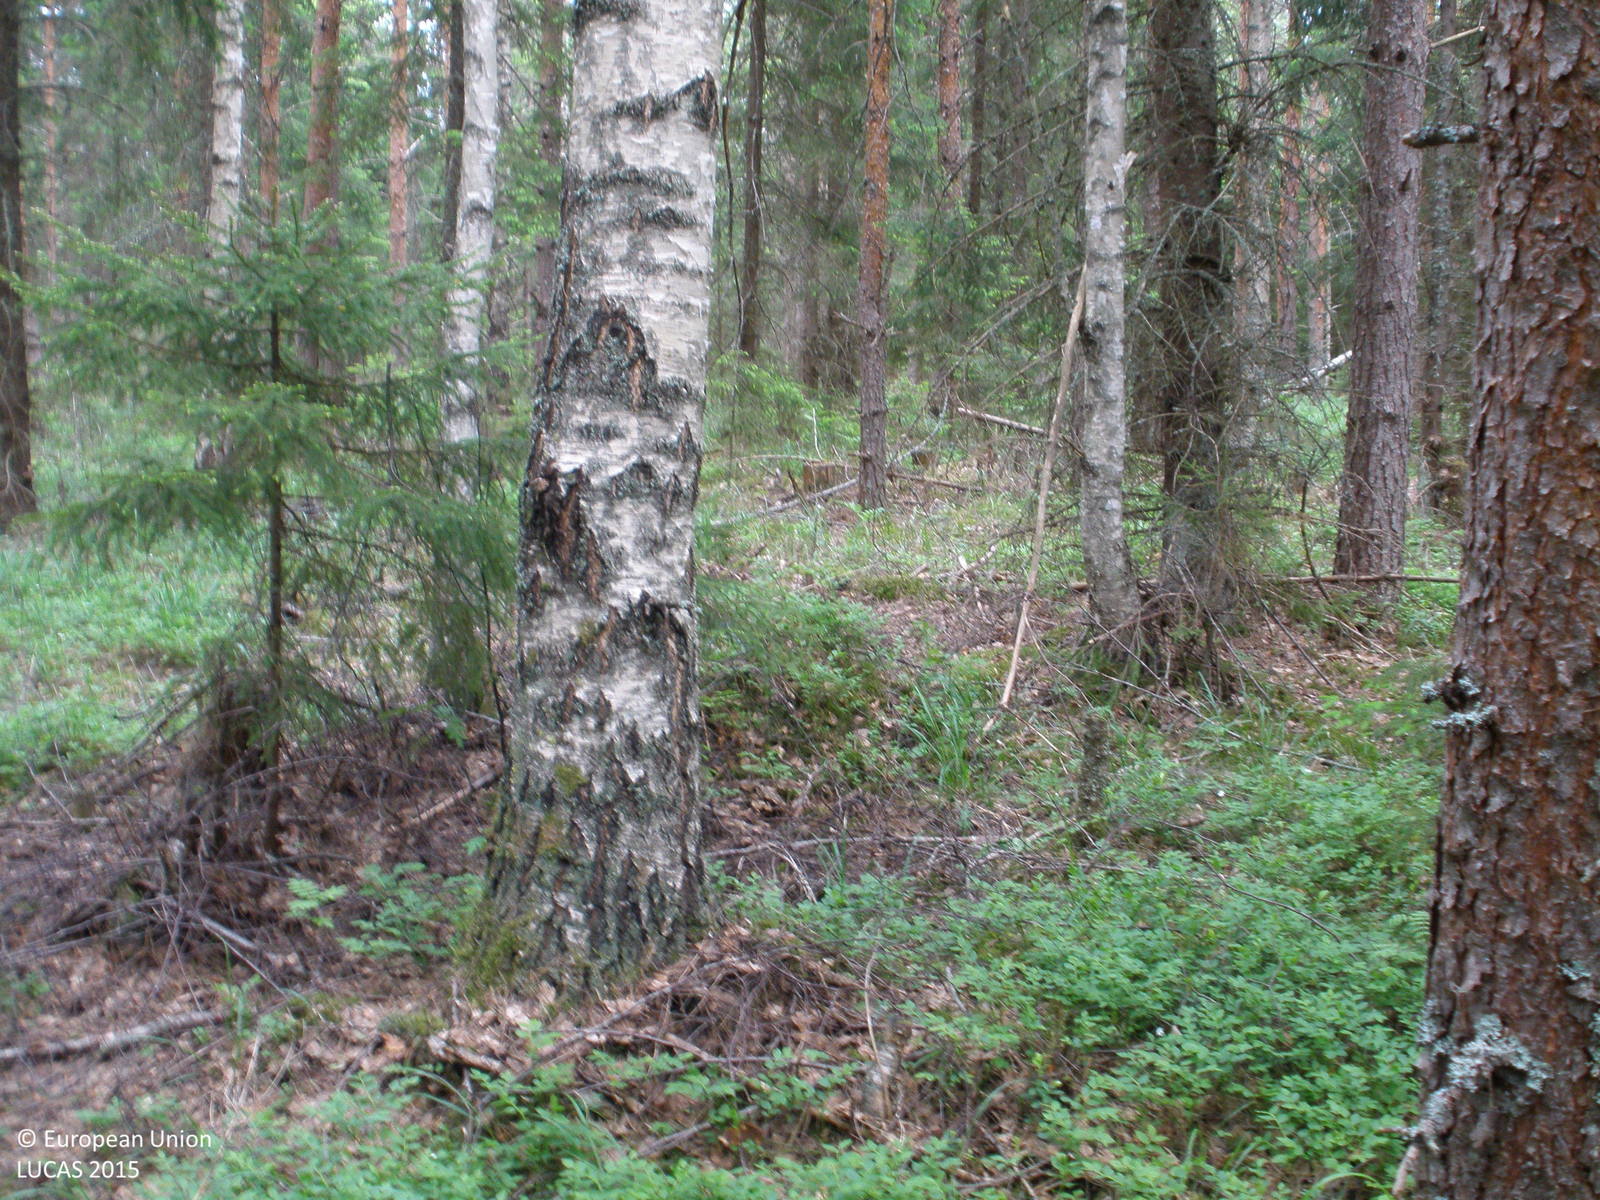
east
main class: Woodland
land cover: Pine dominated mixed woodland
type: boreal forest
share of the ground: > 75 %
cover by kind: coniferous forest trees 60 %, broadleaved forest trees 25 %, herbaceous plants 10 %, shrubs 5 %
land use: Forestry
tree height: > 5 m
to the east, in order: Pine dominated mixed woodland; Other mixed woodland
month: June
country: FI
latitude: 61.0152
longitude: 24.2117
